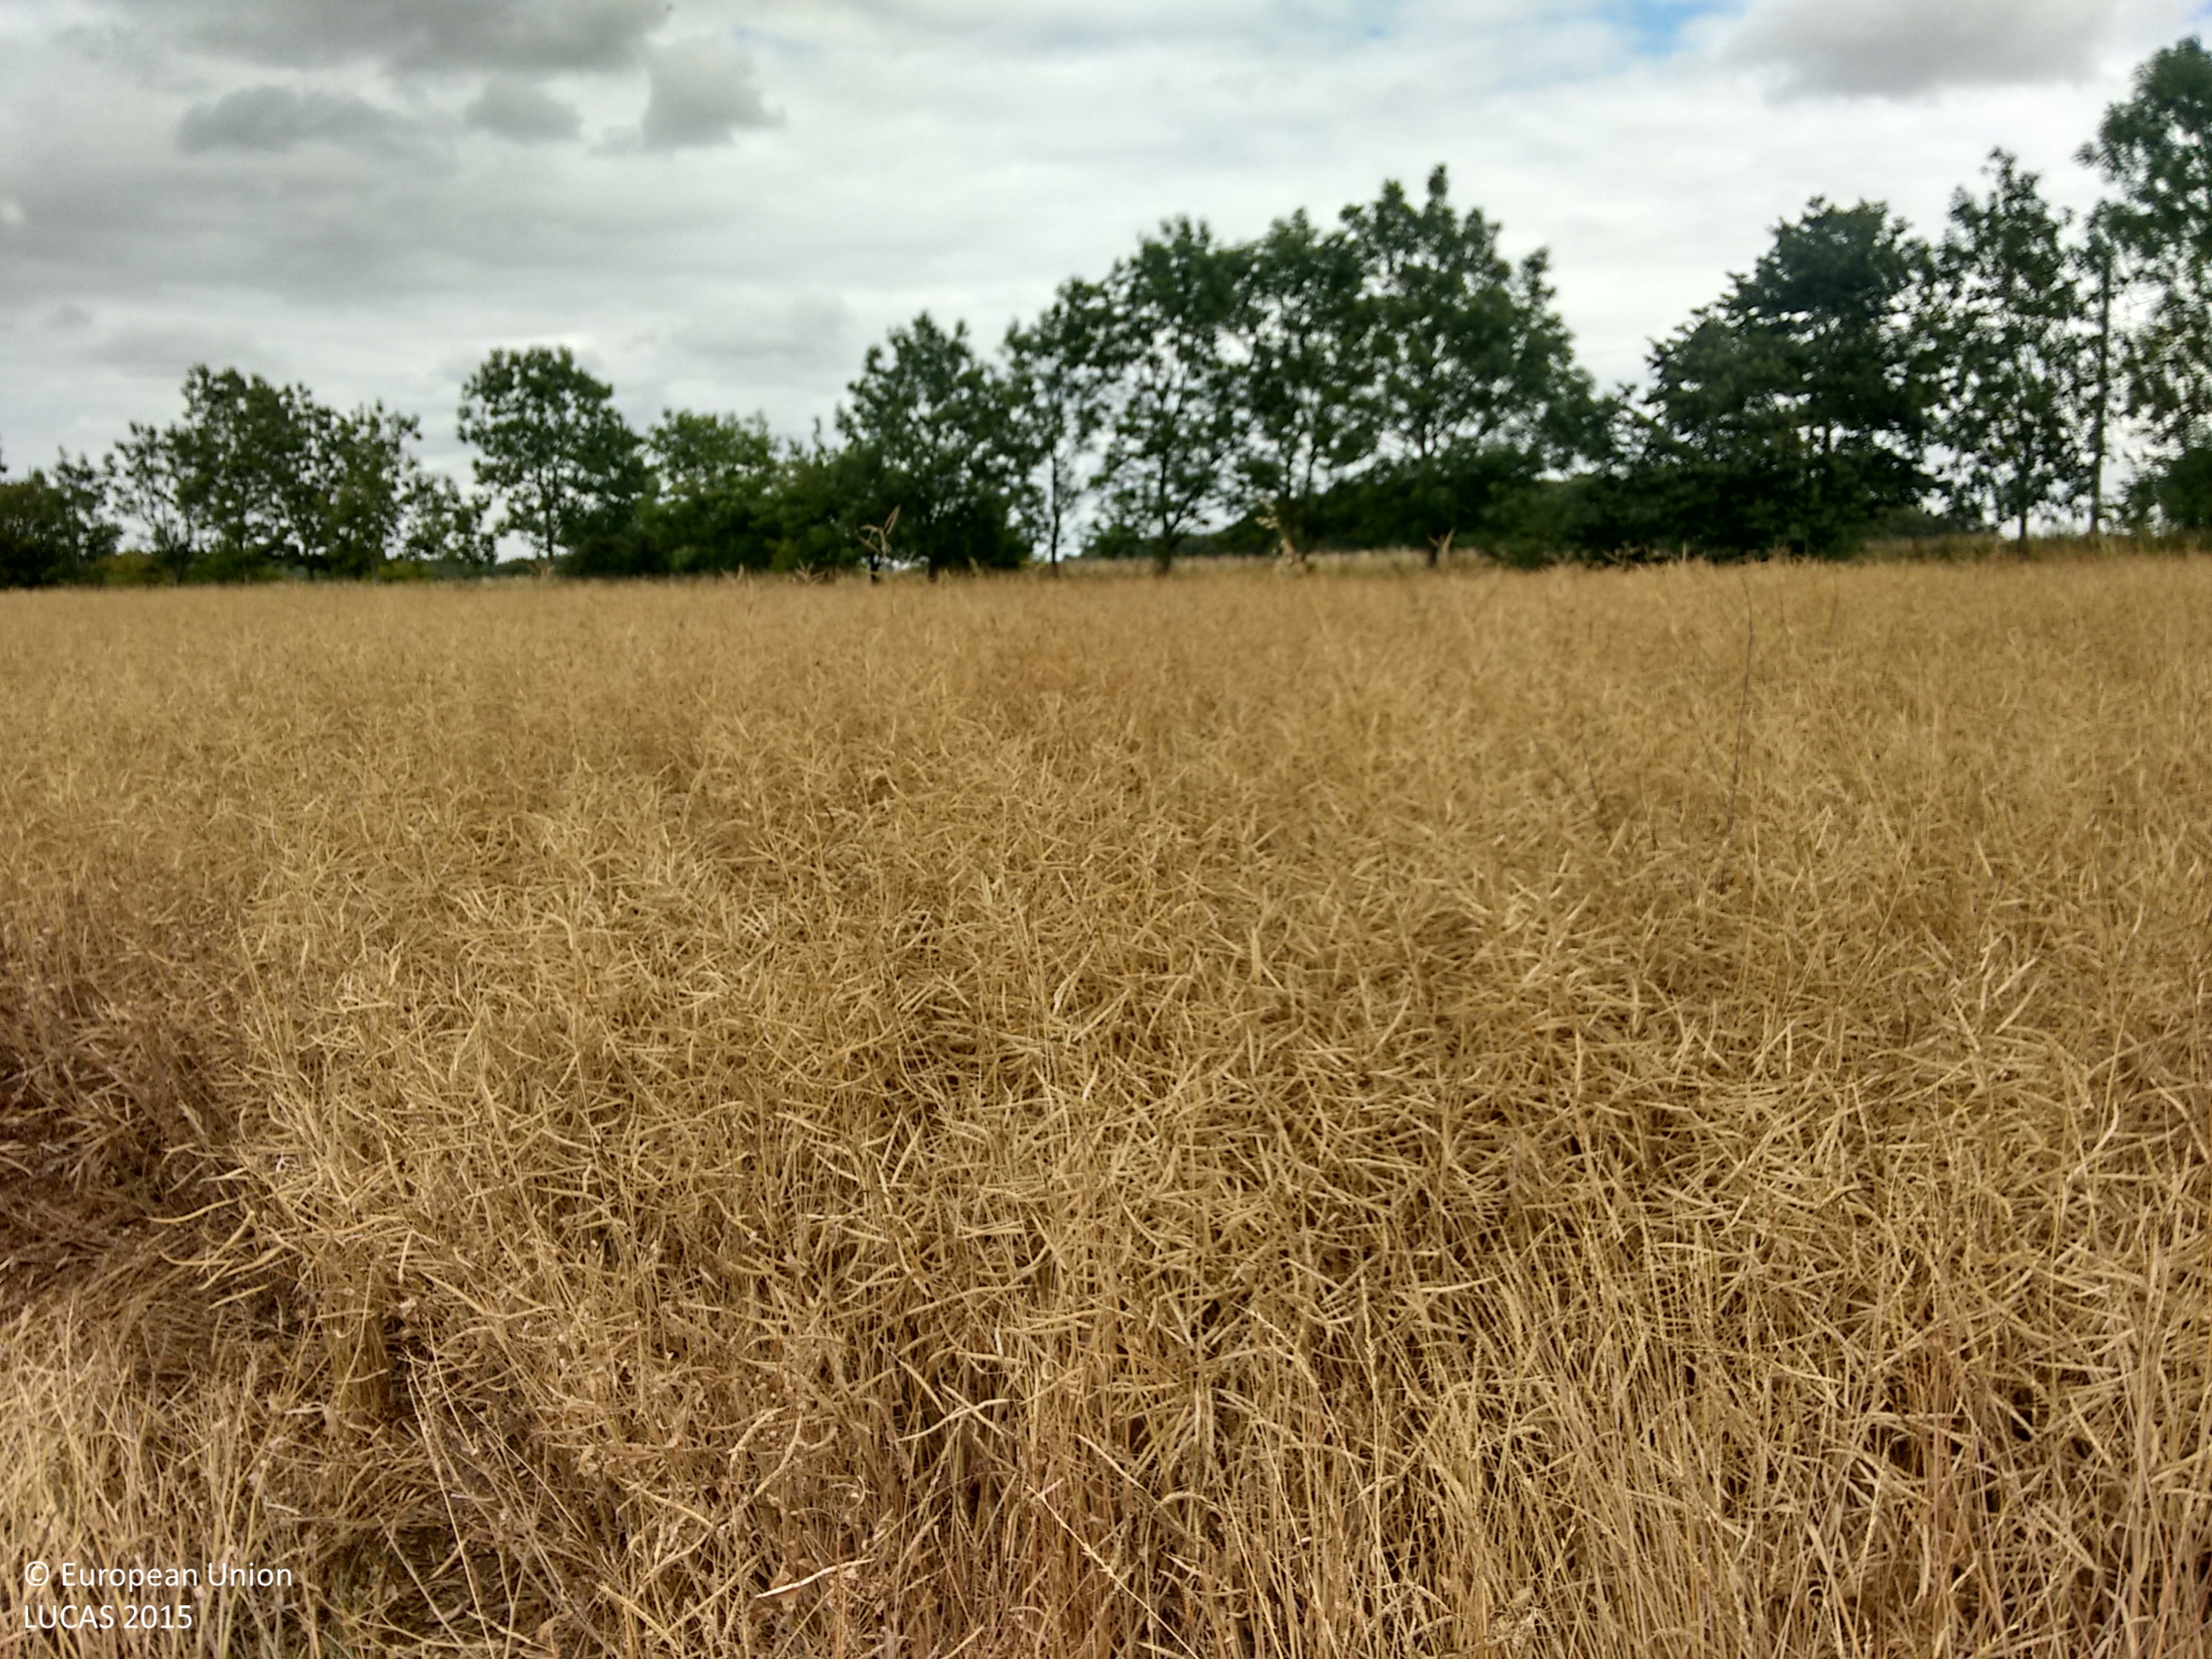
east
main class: Cropland
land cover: Rape and turnip rape
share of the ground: > 75 %
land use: Agriculture (excluding fallow land and kitchen gardens)
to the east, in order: Rape and turnip rape; Grass margins; Ditches and canals; Grass margins; Lines of trees; Grass margins; Paved roads, cycling and walking lanes; Grass margins; Electric lines; Grass margins; Ditches and canals; Grass margins; Barley
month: August
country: GB
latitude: 52.0282
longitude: 0.4543
